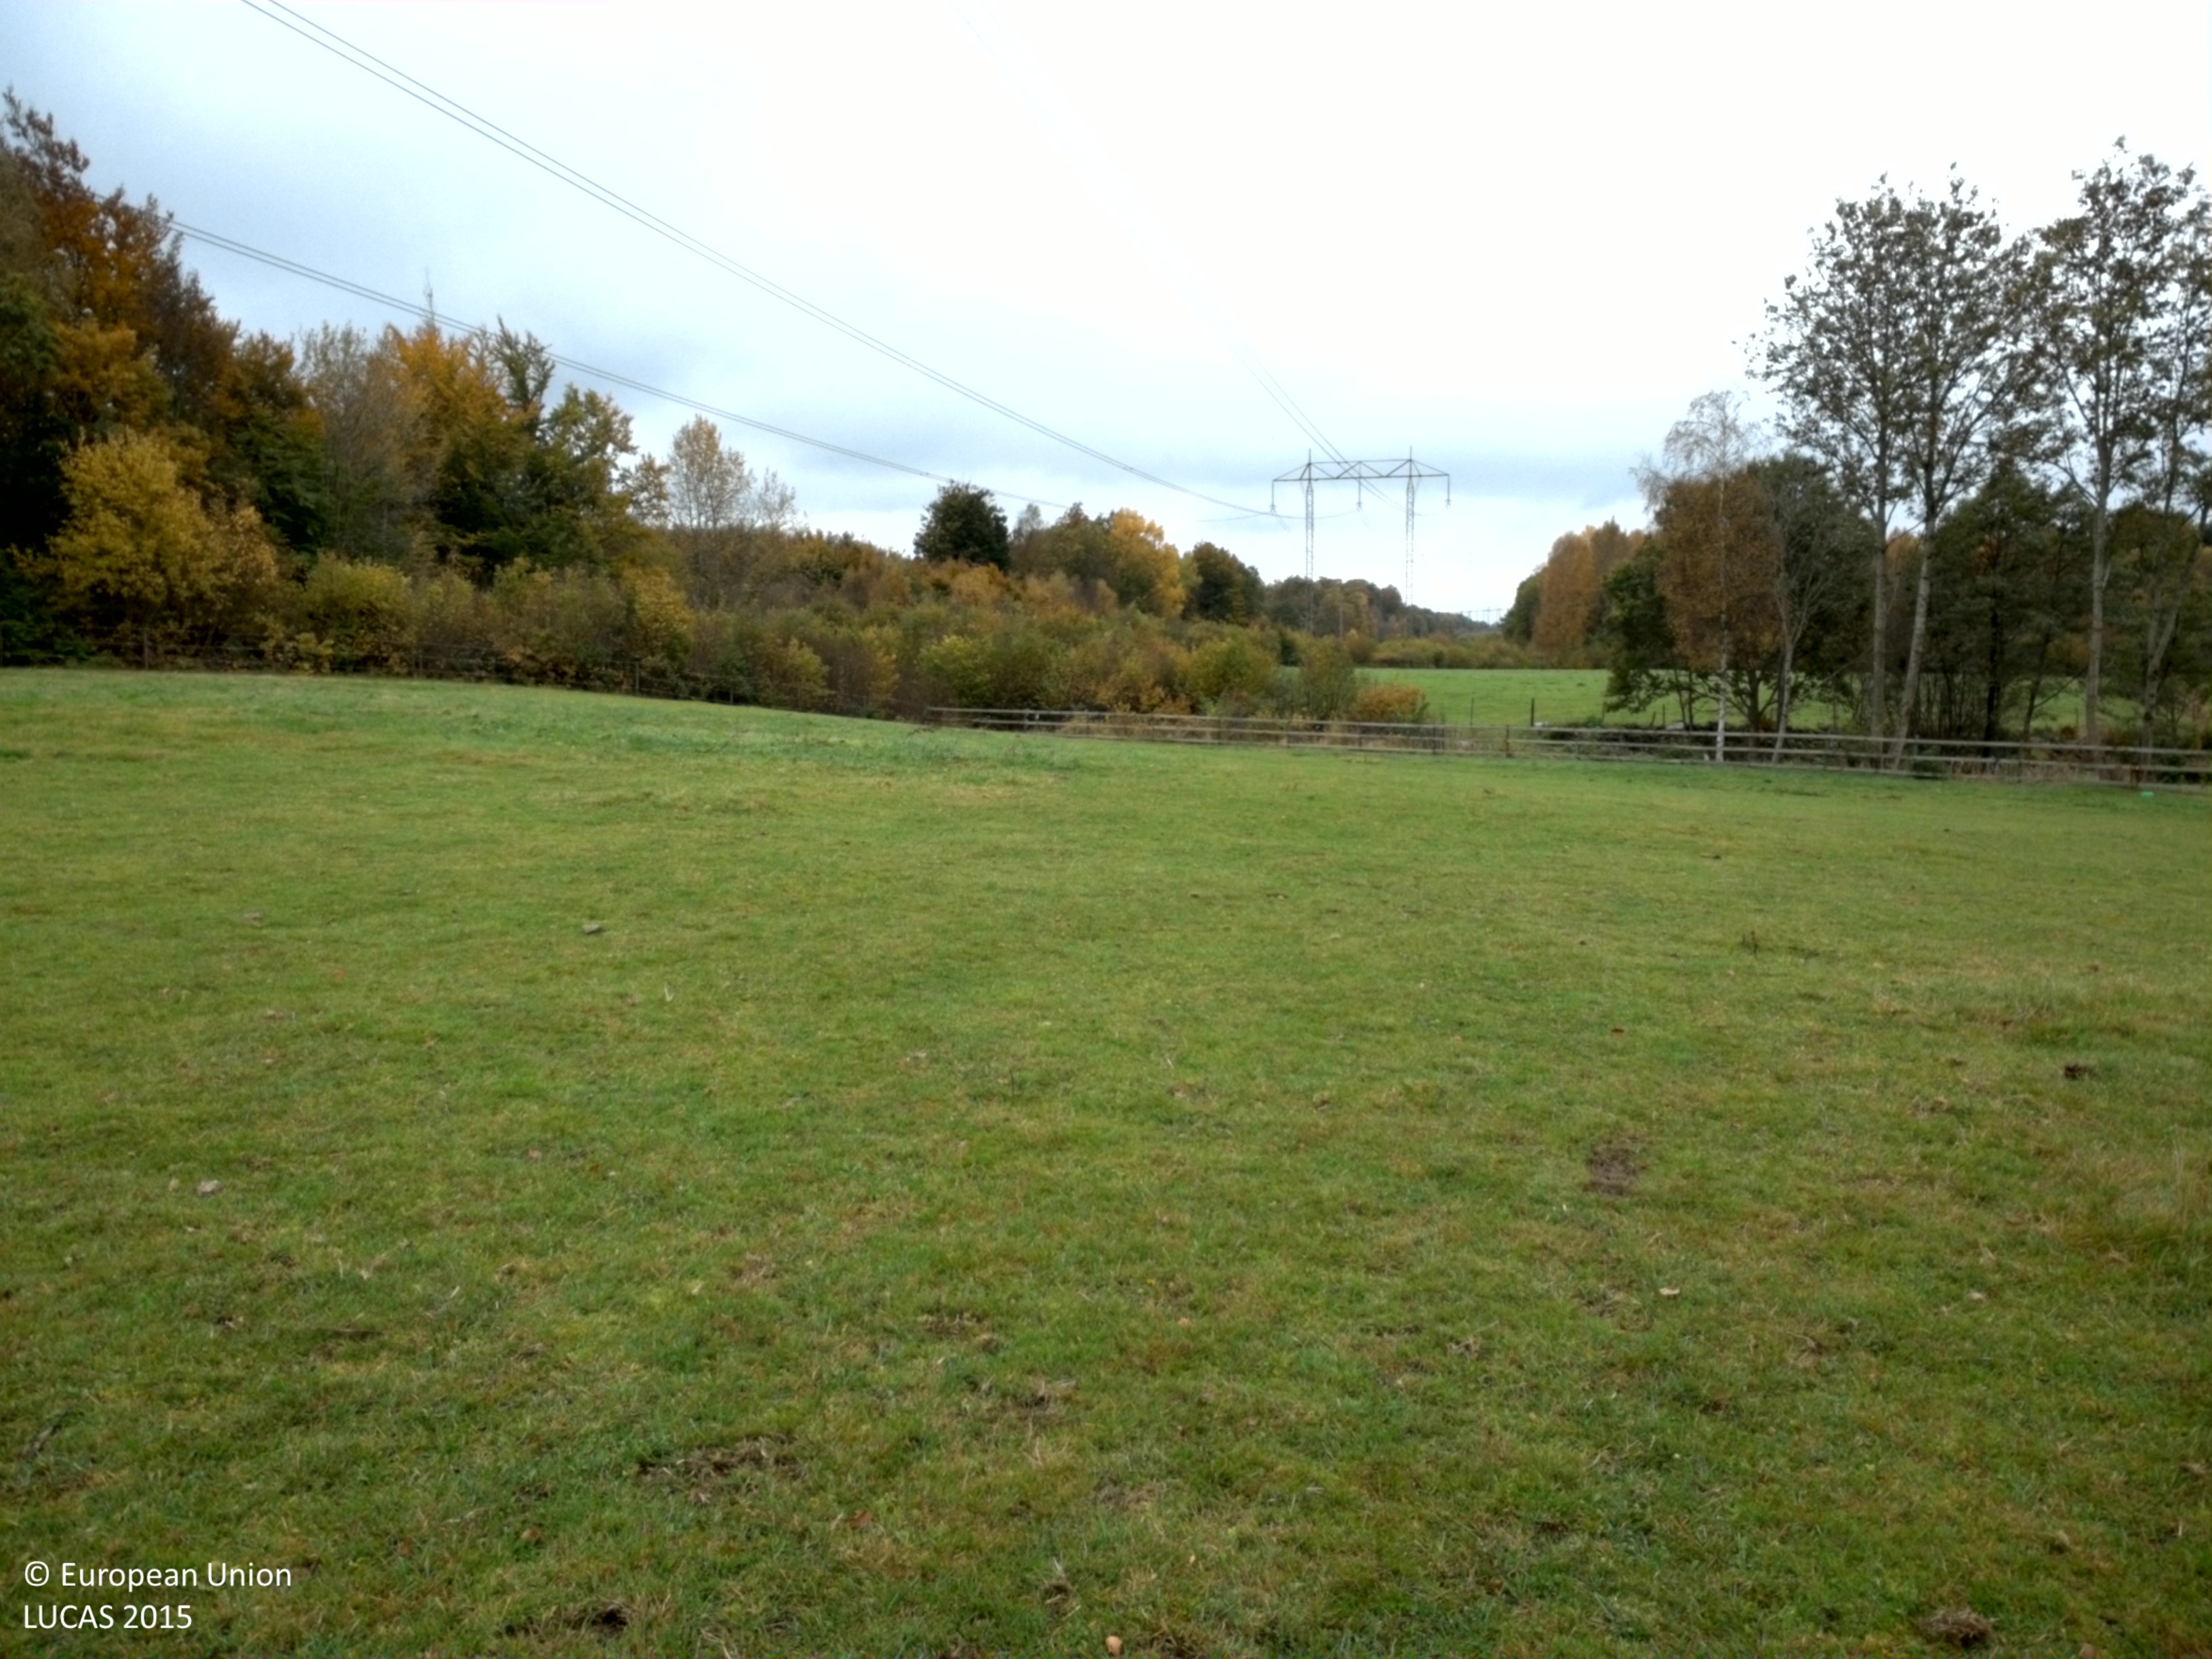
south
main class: Grassland
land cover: Grassland without tree/shrub cover
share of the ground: > 75 %
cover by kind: herbaceous plants 100 %
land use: Agriculture (excluding fallow land and kitchen gardens)
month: October
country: SE
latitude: 55.8828
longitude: 13.6907
